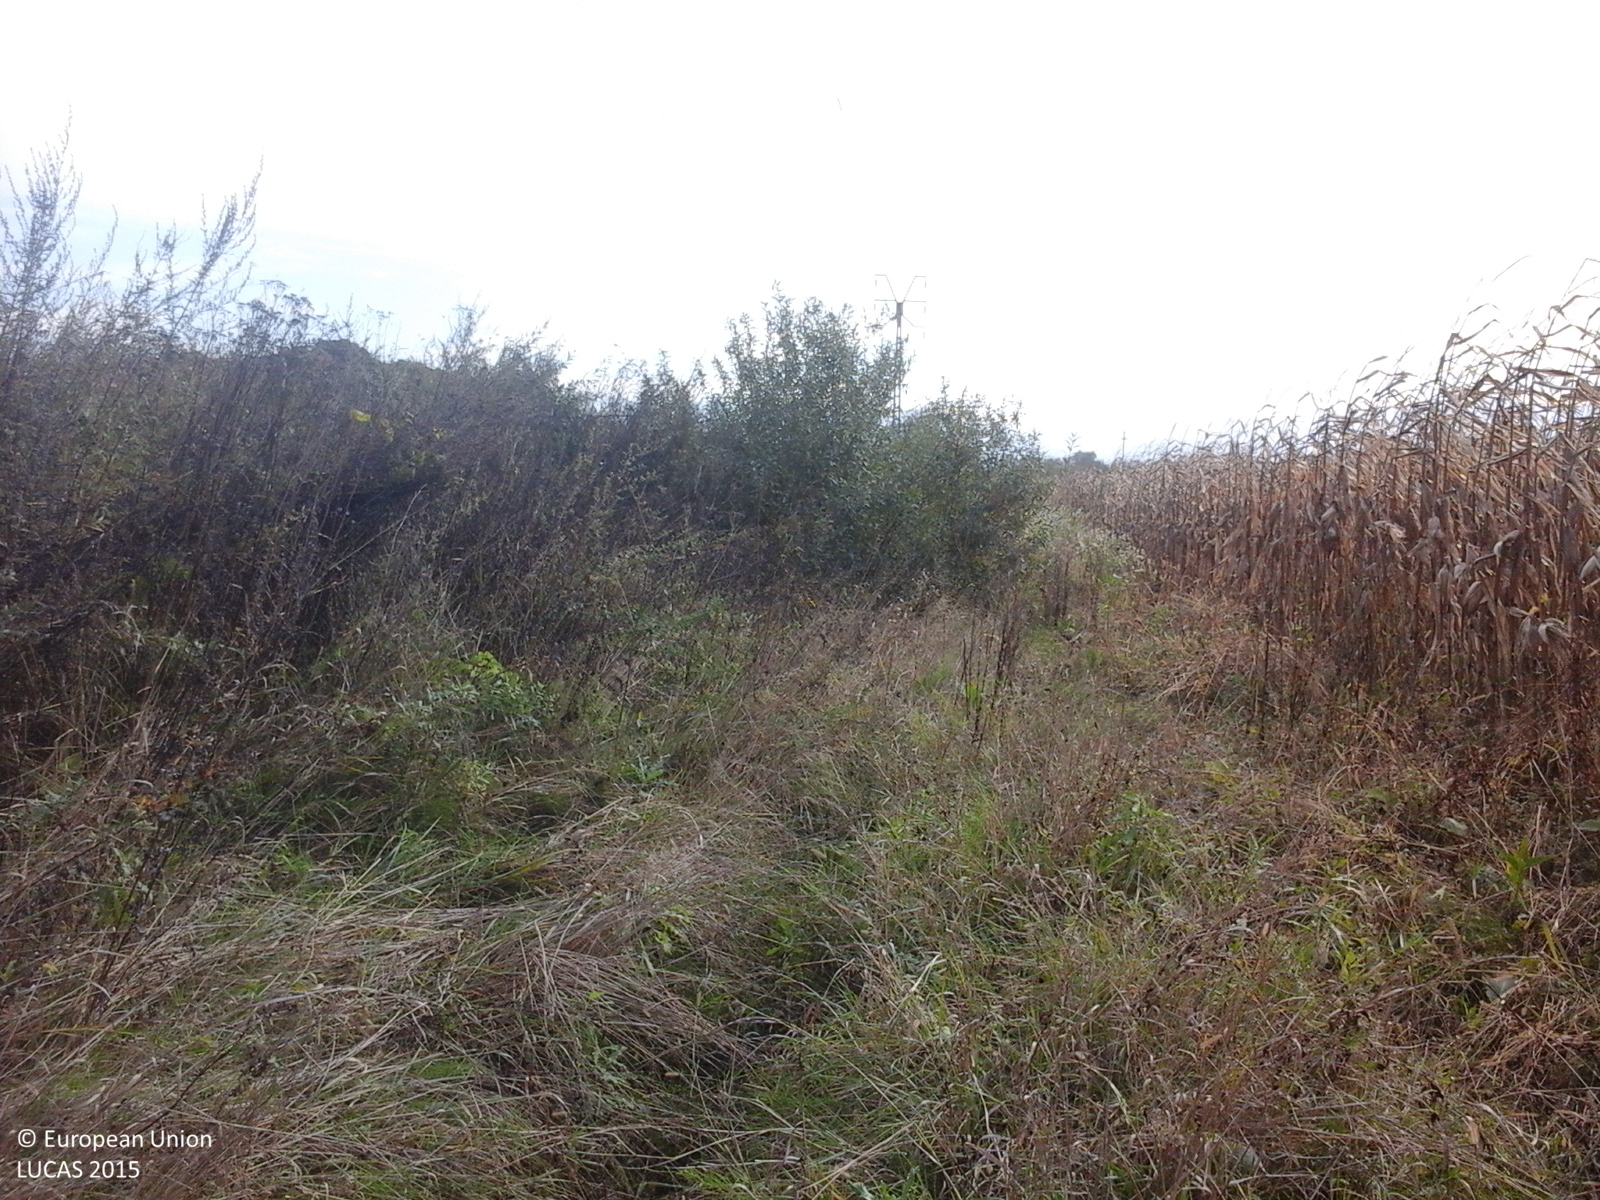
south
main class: Grassland
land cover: Spontaneously vegetated surfaces
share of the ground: > 75 %
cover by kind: herbaceous plants 100 %
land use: Fallow land
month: October
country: RO
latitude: 45.8297
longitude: 25.0388
